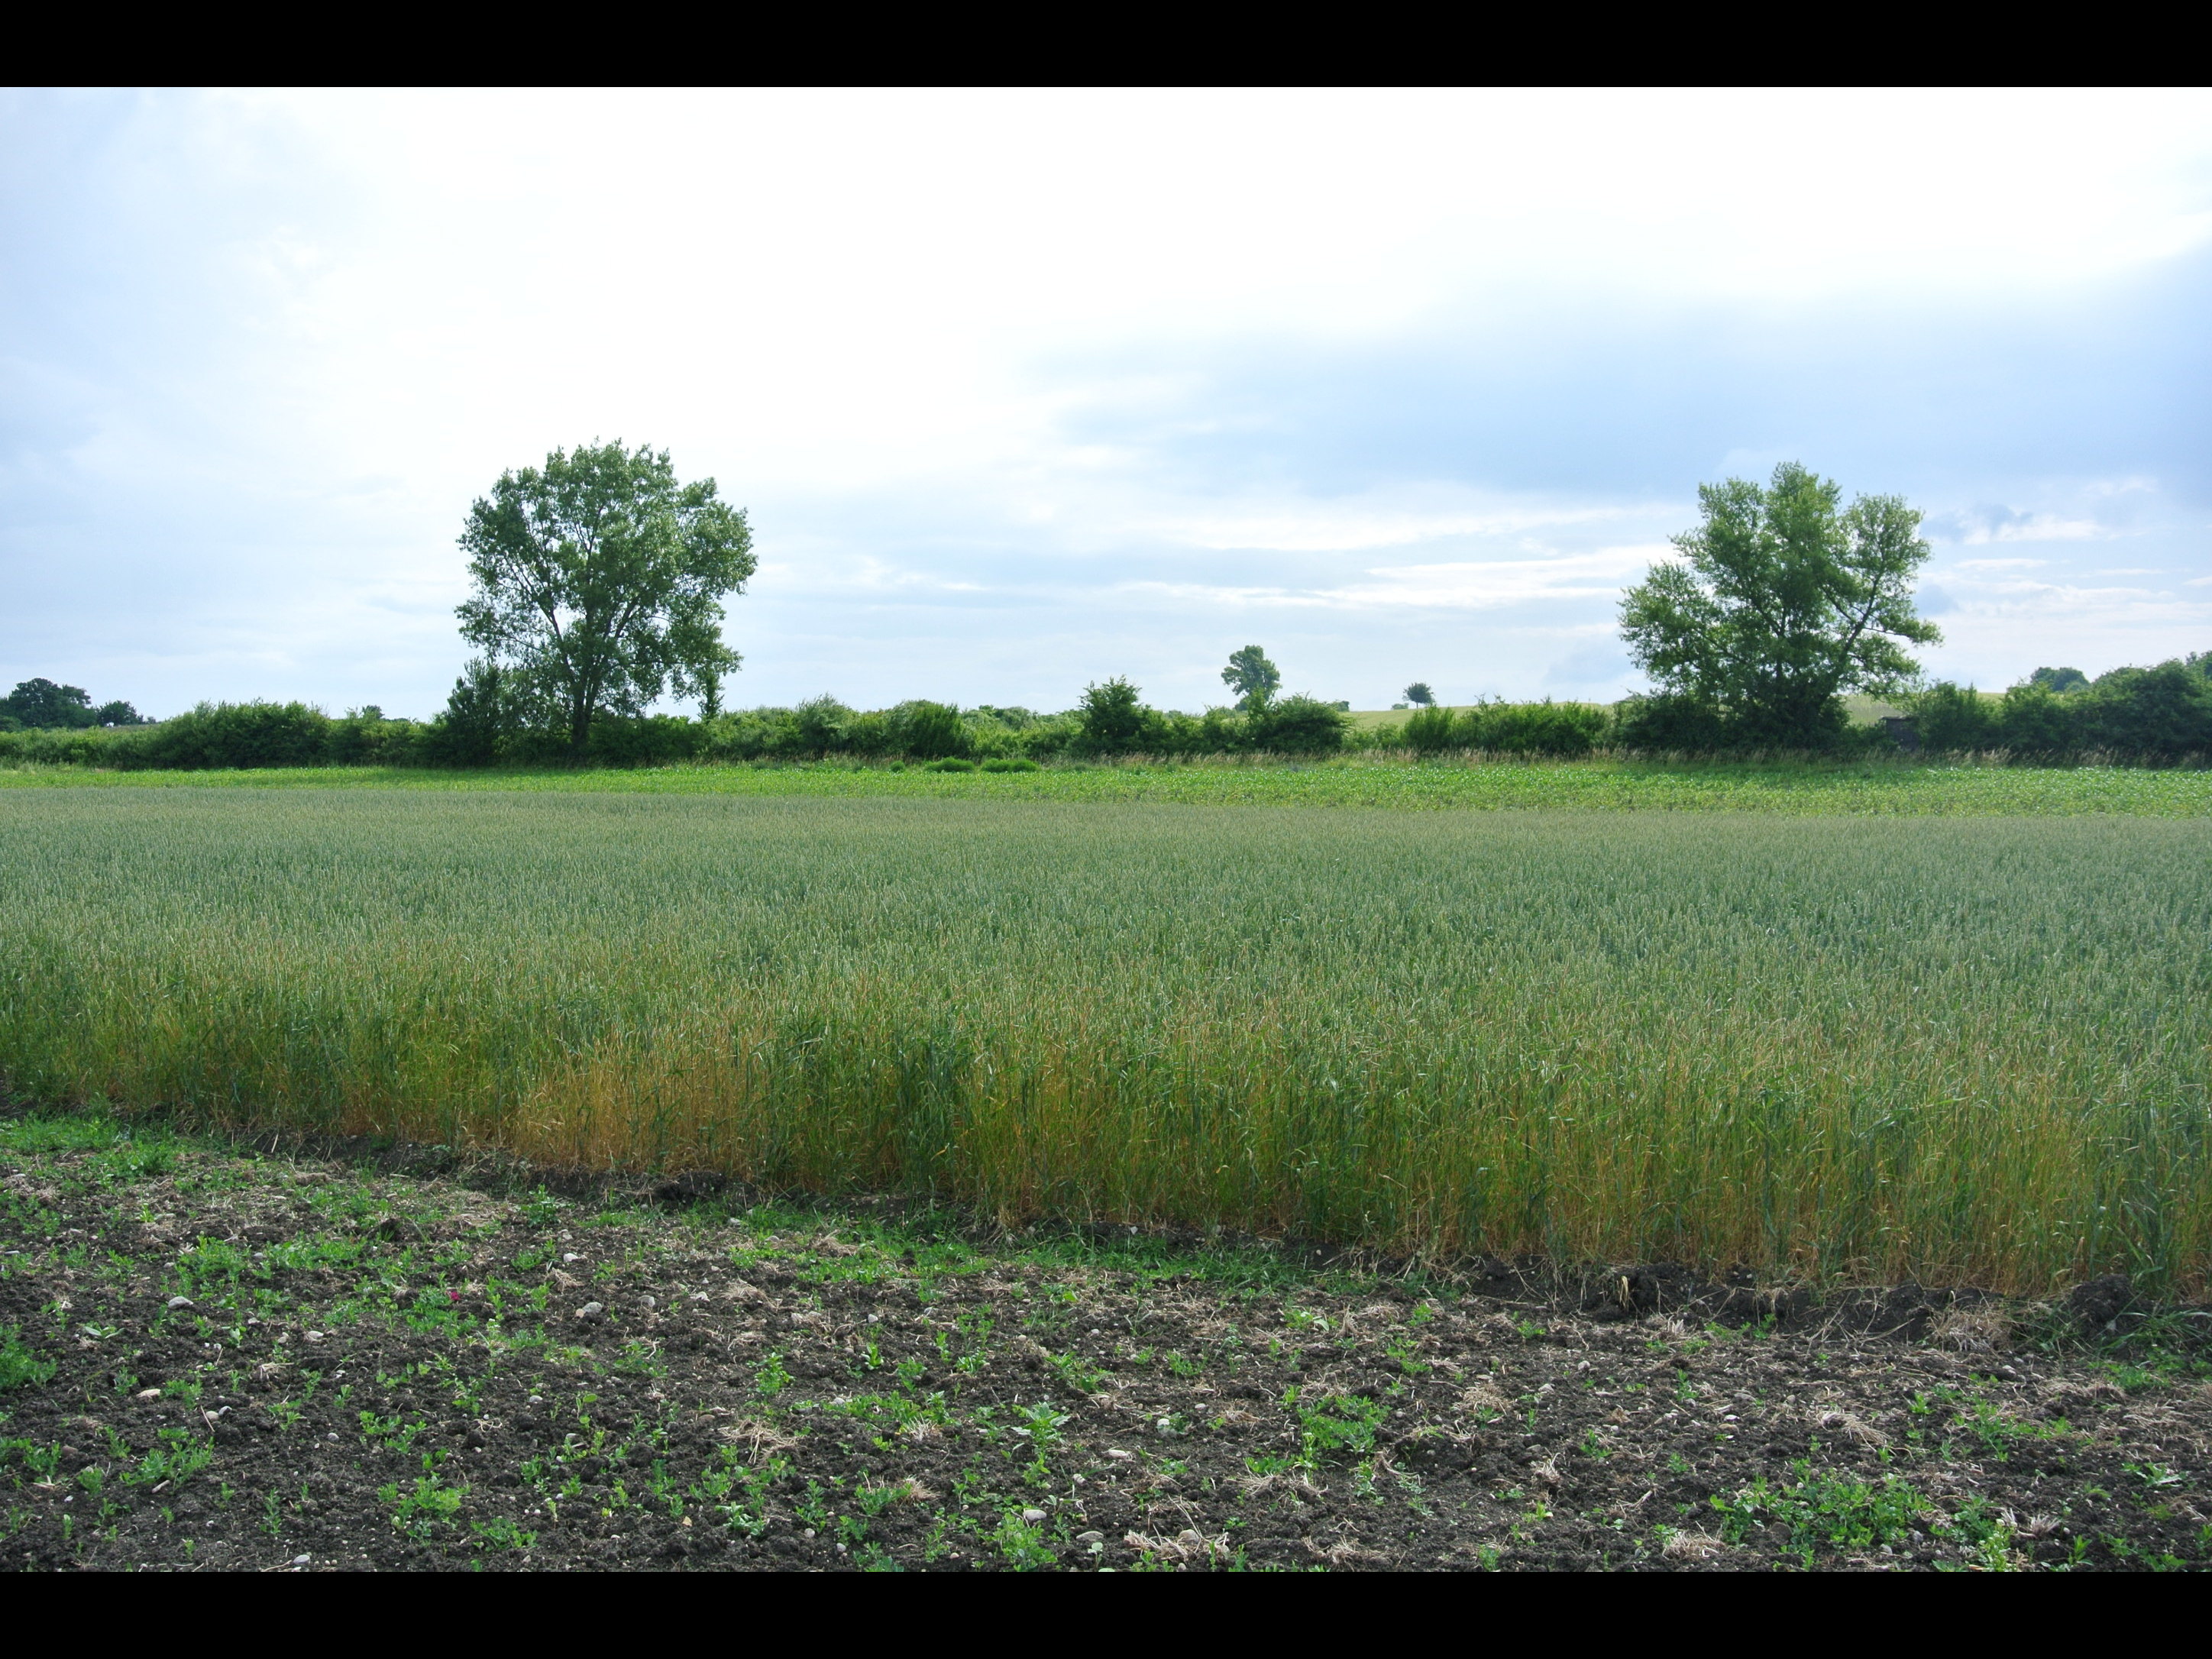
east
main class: Grassland
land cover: Spontaneously vegetated surfaces
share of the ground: 25 - 50 %
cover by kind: unconsolidated bare surface 55 %, herbaceous plants 45 %
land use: Agriculture (excluding fallow land and kitchen gardens)
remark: Harvested field
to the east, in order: Spontaneously vegetated surfaces; Rye; Sugar beet; Grass margins; Broadleaved woodland; Electric lines; Railways; Grass margins; Tracks; Common wheat
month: June
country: AT
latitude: 47.9048
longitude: 16.1978
